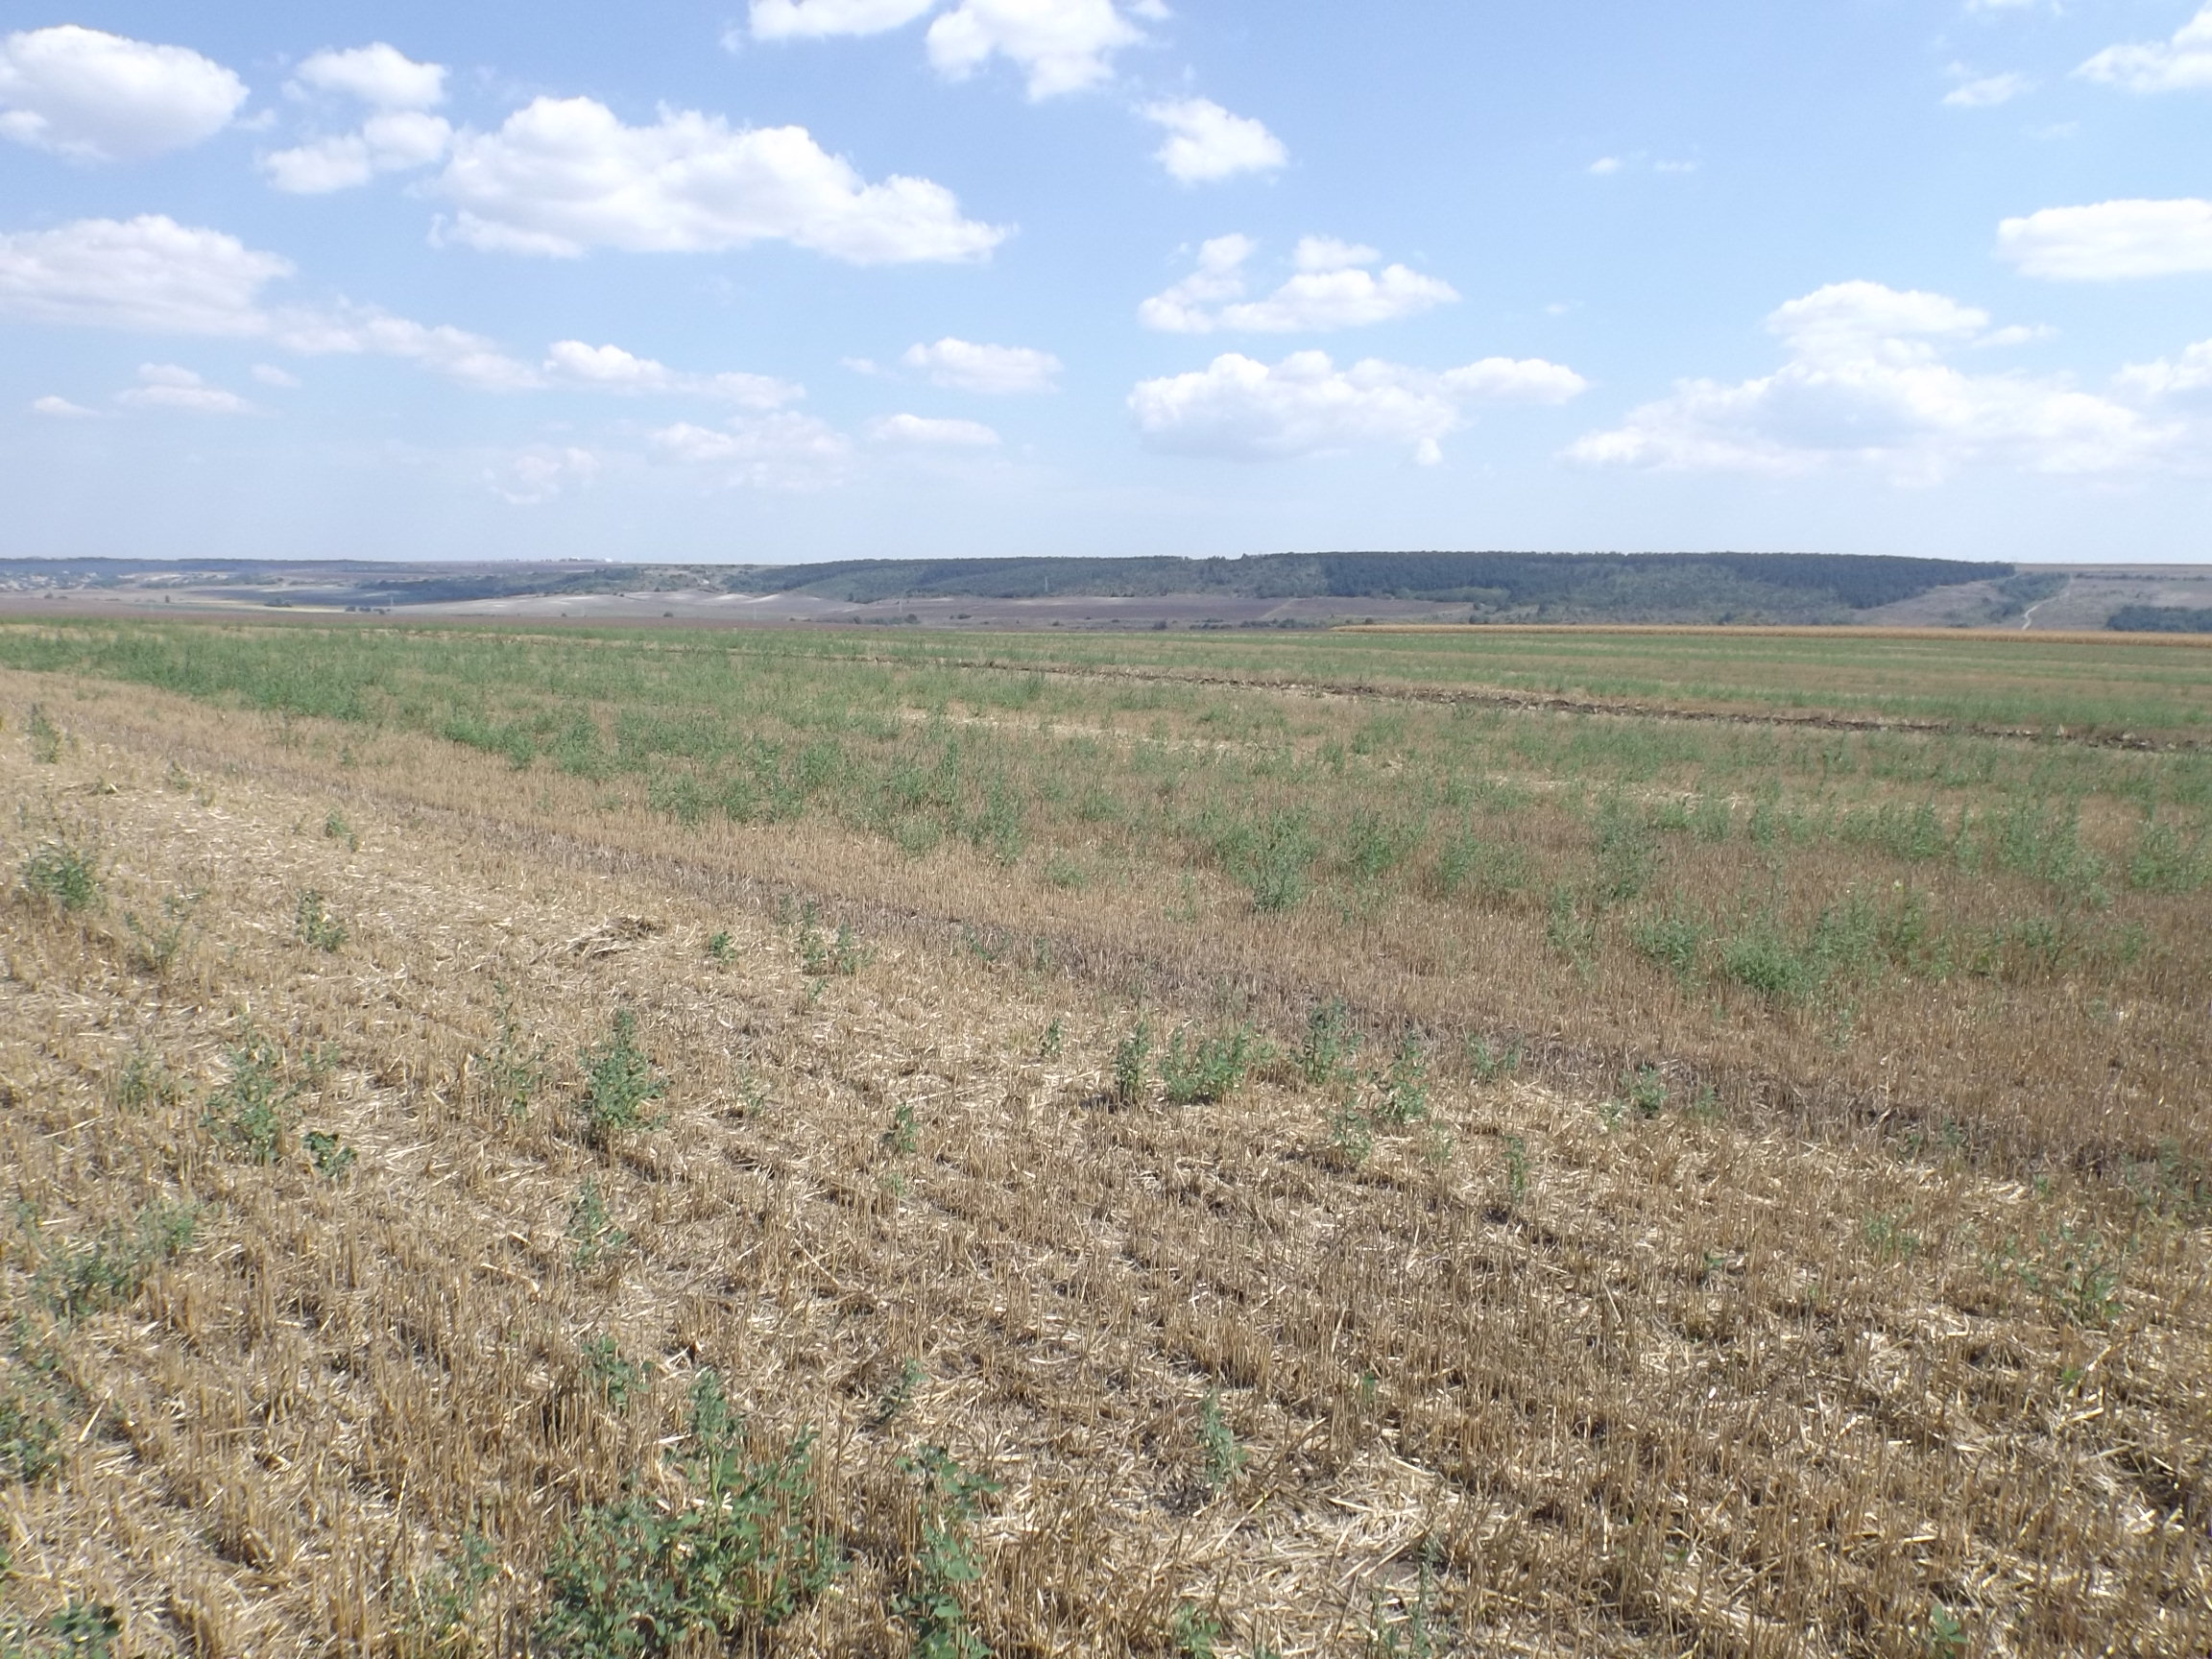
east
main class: Cropland
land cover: Common wheat
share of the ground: 50 - 75 %
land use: Agriculture (excluding fallow land and kitchen gardens)
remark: Harvested field
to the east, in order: Common wheat; Tracks; Common wheat
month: August
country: BG
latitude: 43.4406
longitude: 27.4893
